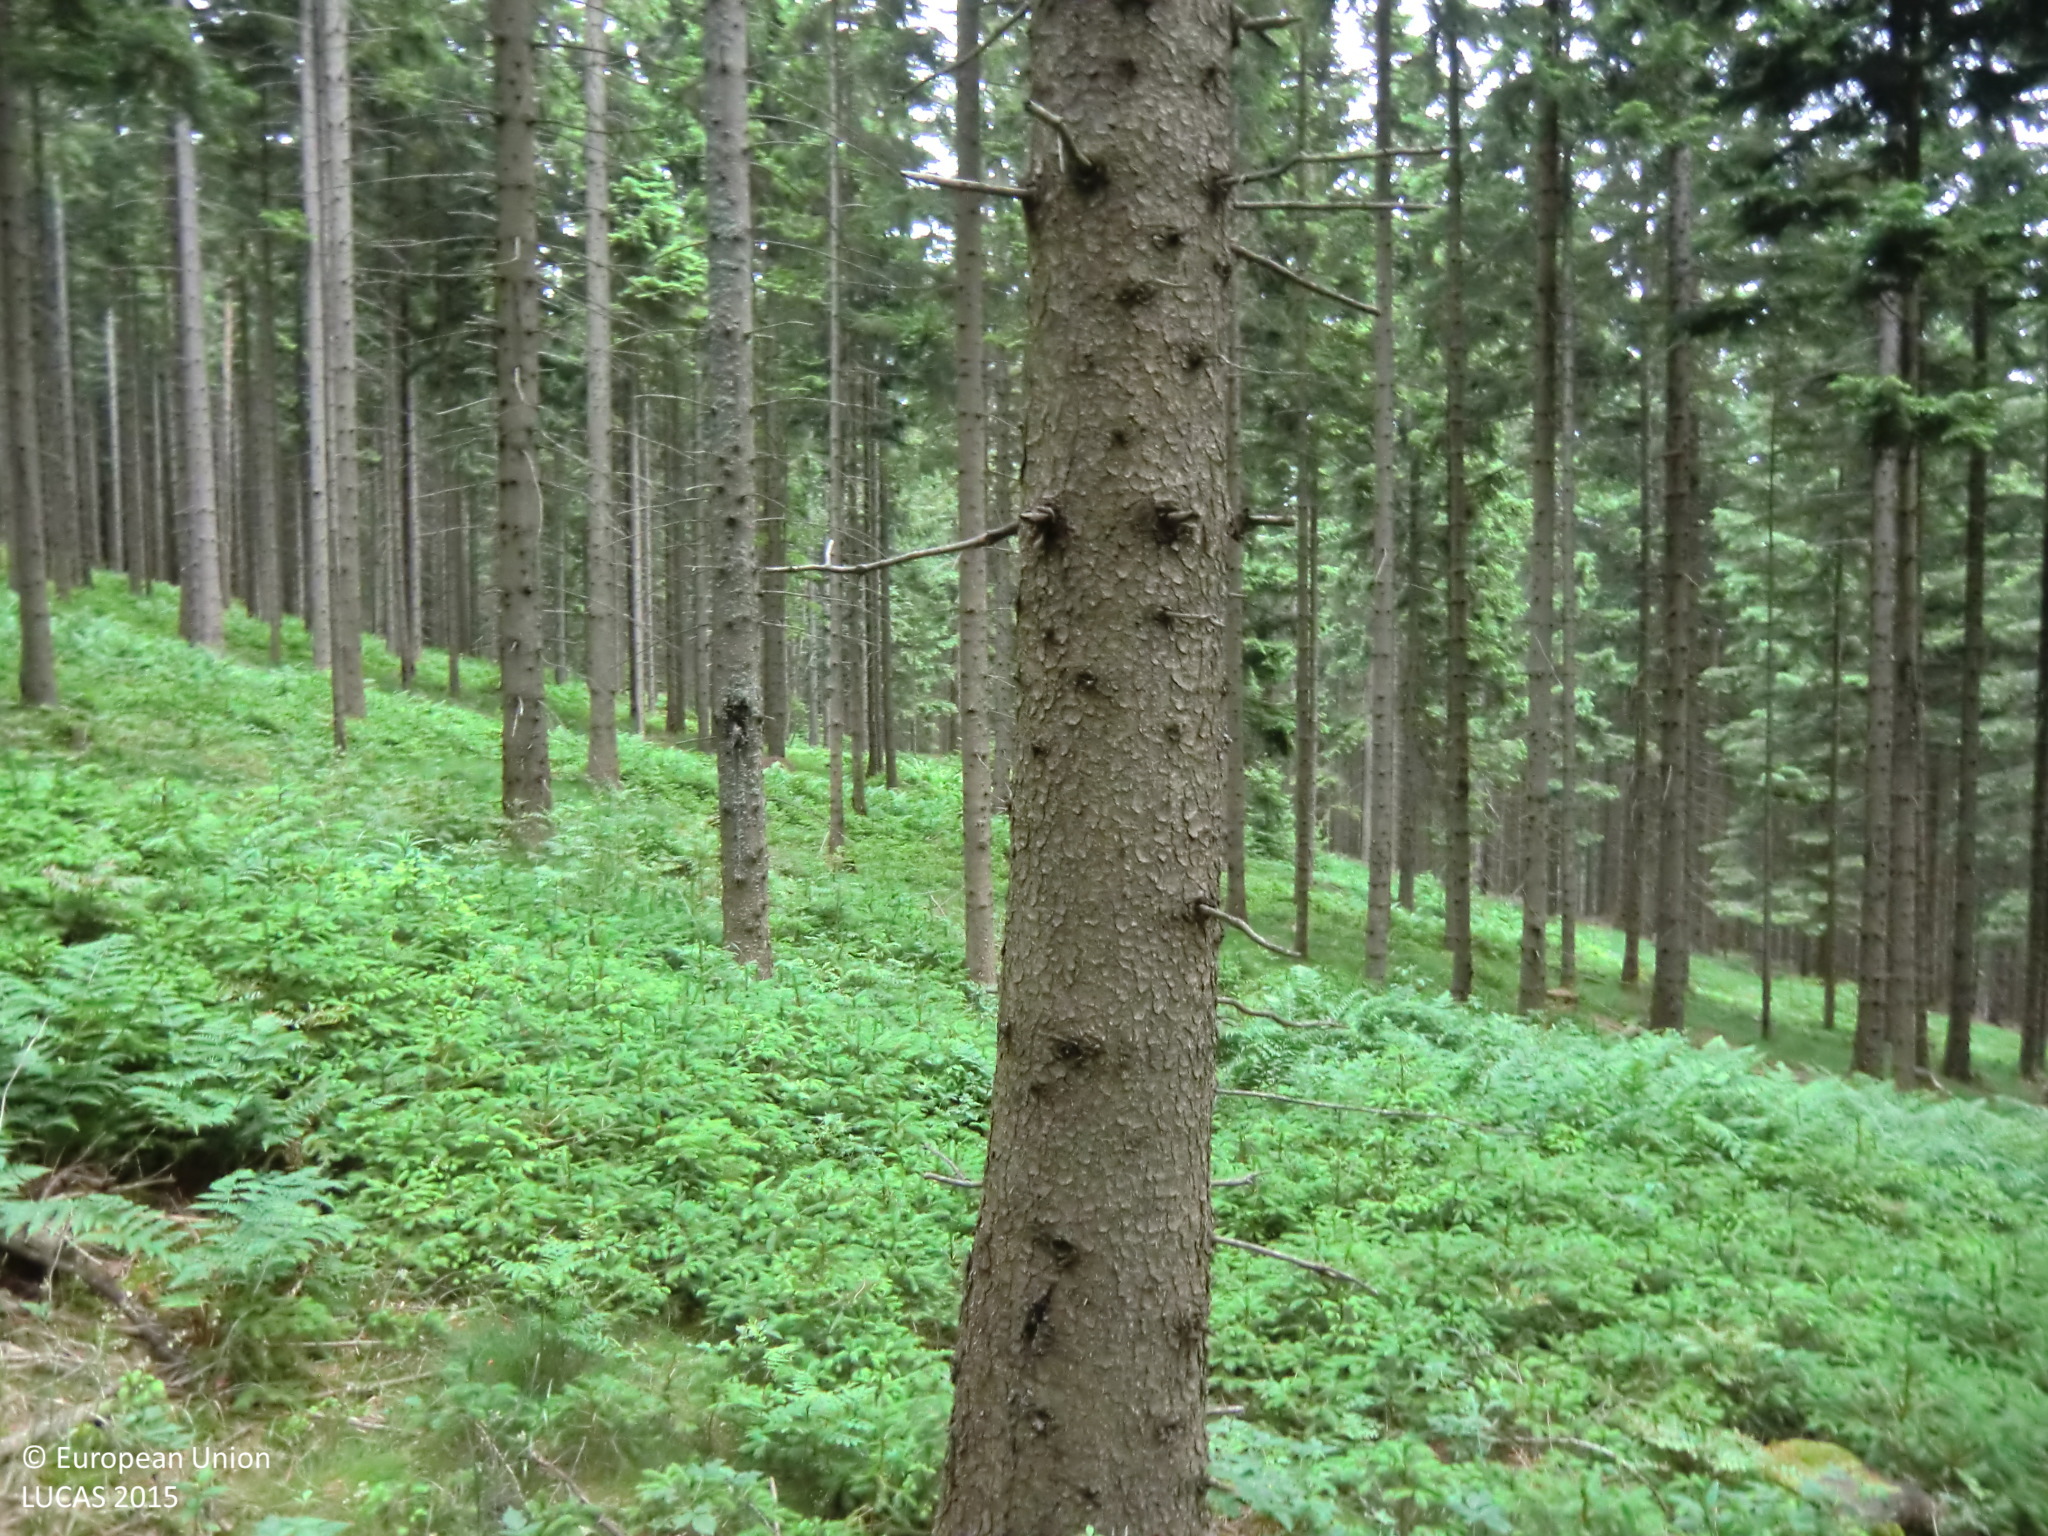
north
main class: Woodland
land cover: Spruce dominated coniferous woodland
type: alpine coniferous forest
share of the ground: > 75 %
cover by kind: coniferous forest trees 80 %, shrubs 10 %, herbaceous plants 10 %
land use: Forestry
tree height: > 5 m
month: June
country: AT
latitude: 47.2974
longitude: 15.7538
